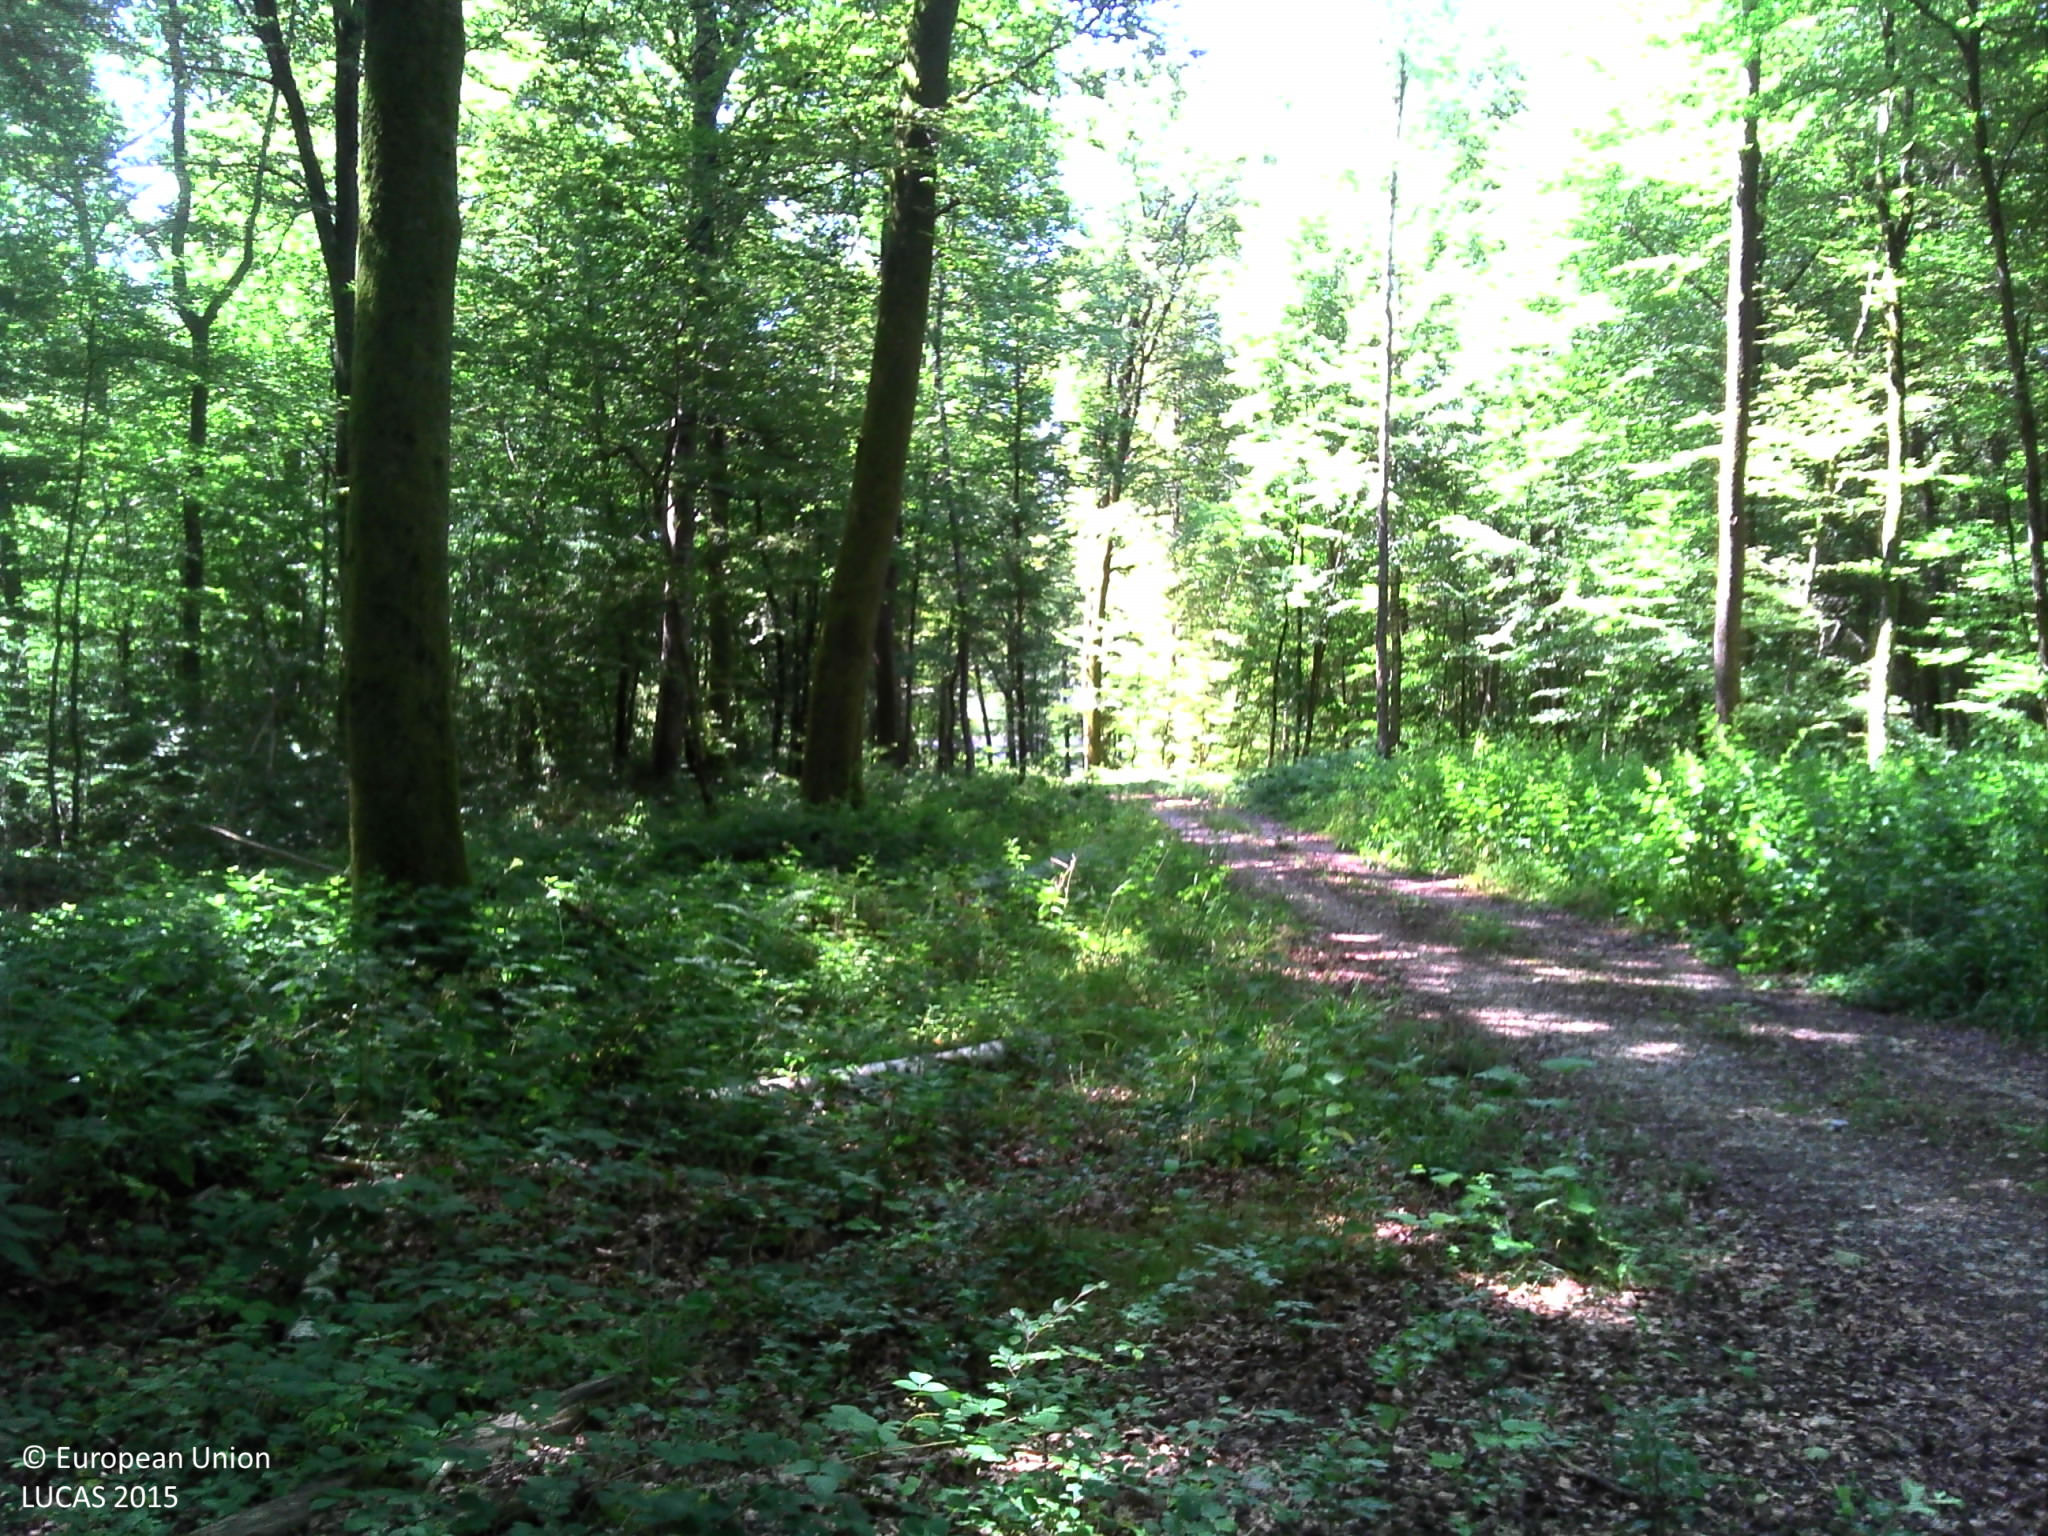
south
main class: Woodland
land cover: Broadleaved woodland
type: beech forest
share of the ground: > 75 %
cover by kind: broadleaved forest trees 90 %, shrubs 5 %, herbaceous plants 5 %
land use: Forestry
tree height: > 5 m
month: June
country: FR
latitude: 47.4552
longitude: 6.1948
